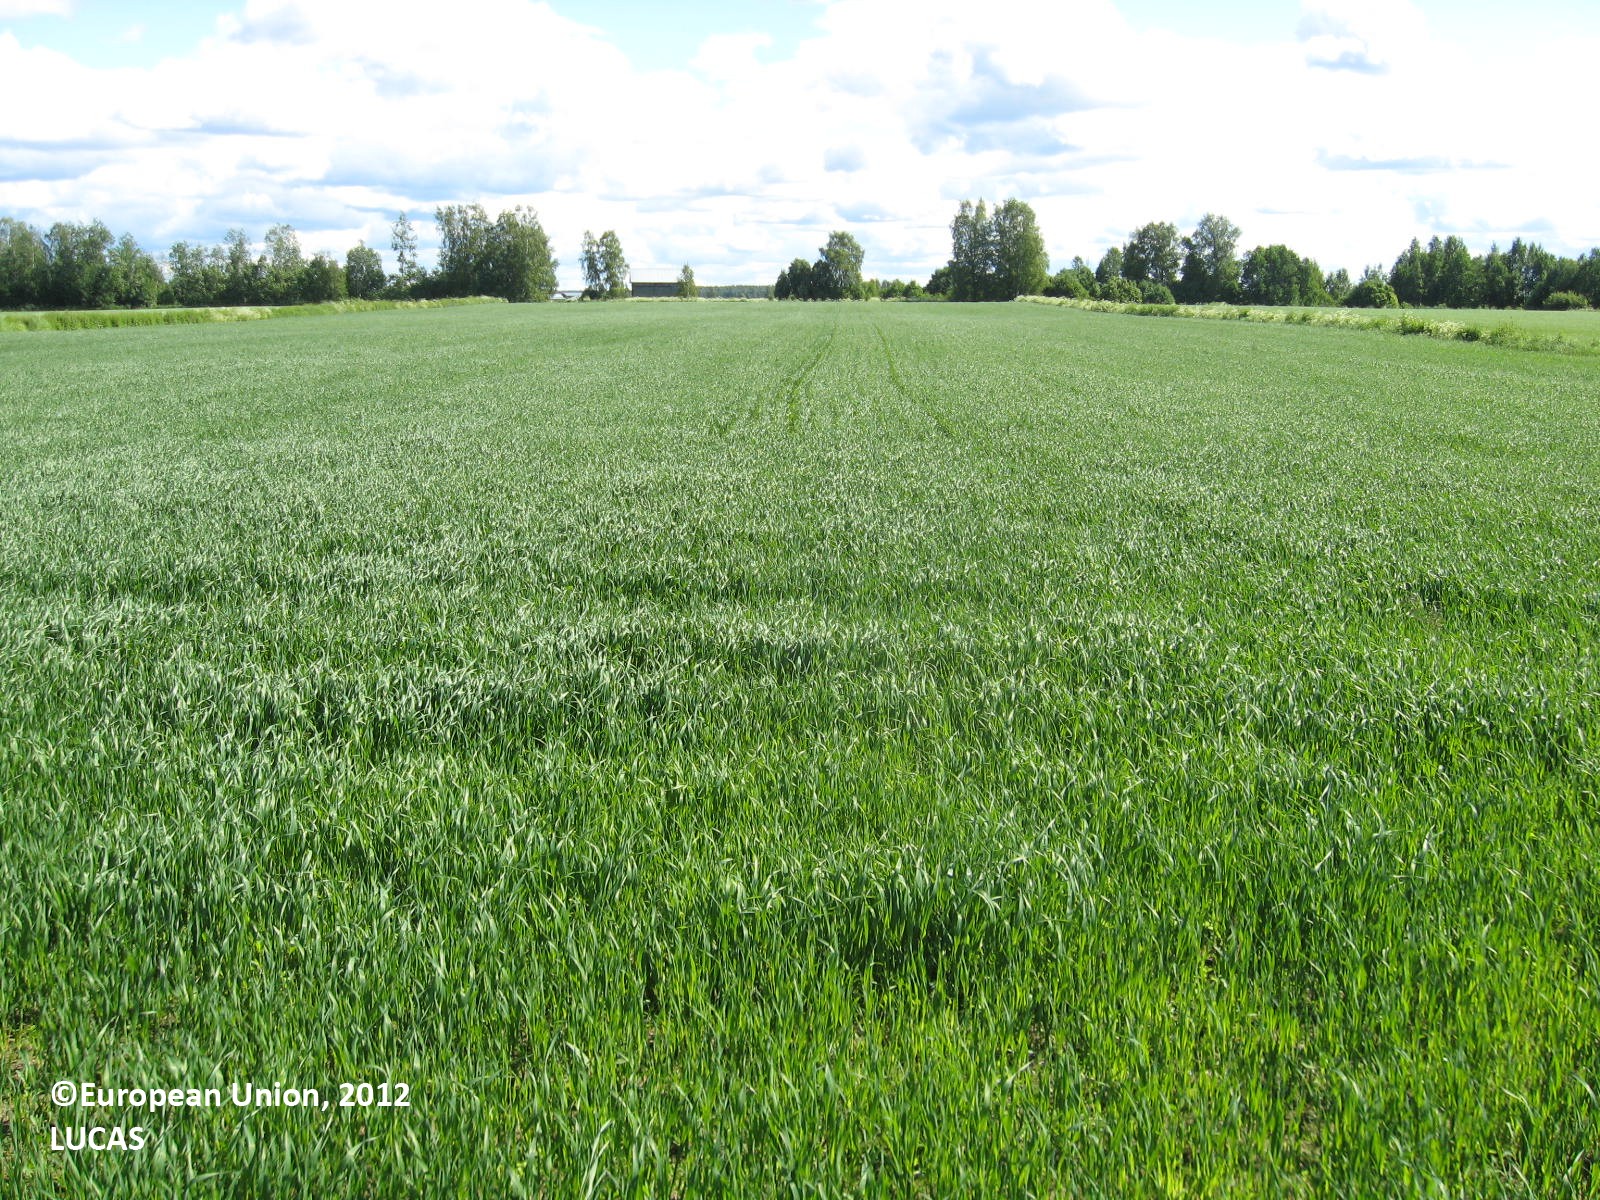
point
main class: Cropland
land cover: Oats
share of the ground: 50 - 75 %
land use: Agriculture (excluding fallow land and kitchen gardens)
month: June
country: FI
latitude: 62.7750
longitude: 22.6142
